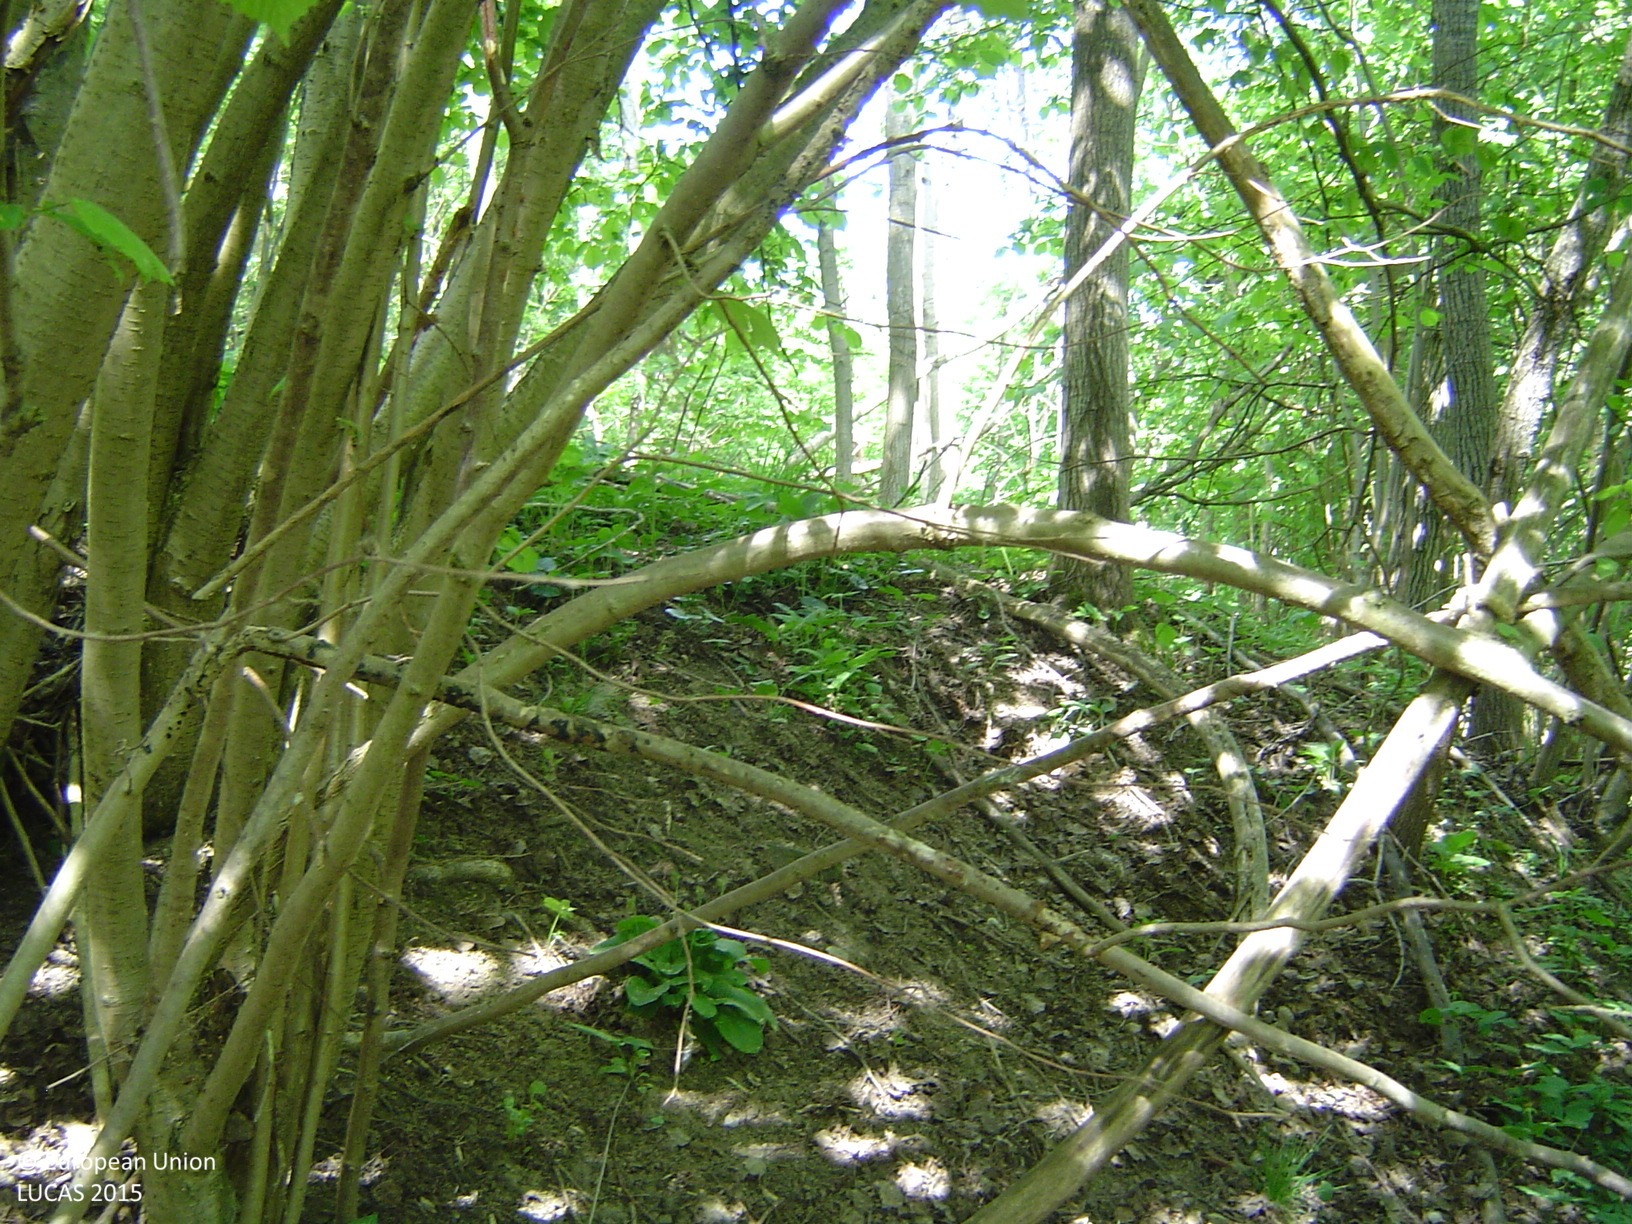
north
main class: Woodland
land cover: Broadleaved woodland
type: mesophytic deciduous forest
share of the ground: > 75 %
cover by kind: broadleaved forest trees 90 %, shrubs 5 %, herbaceous plants 5 %
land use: Forestry
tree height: > 5 m
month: May
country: CZ
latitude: 49.4190
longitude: 16.2232
